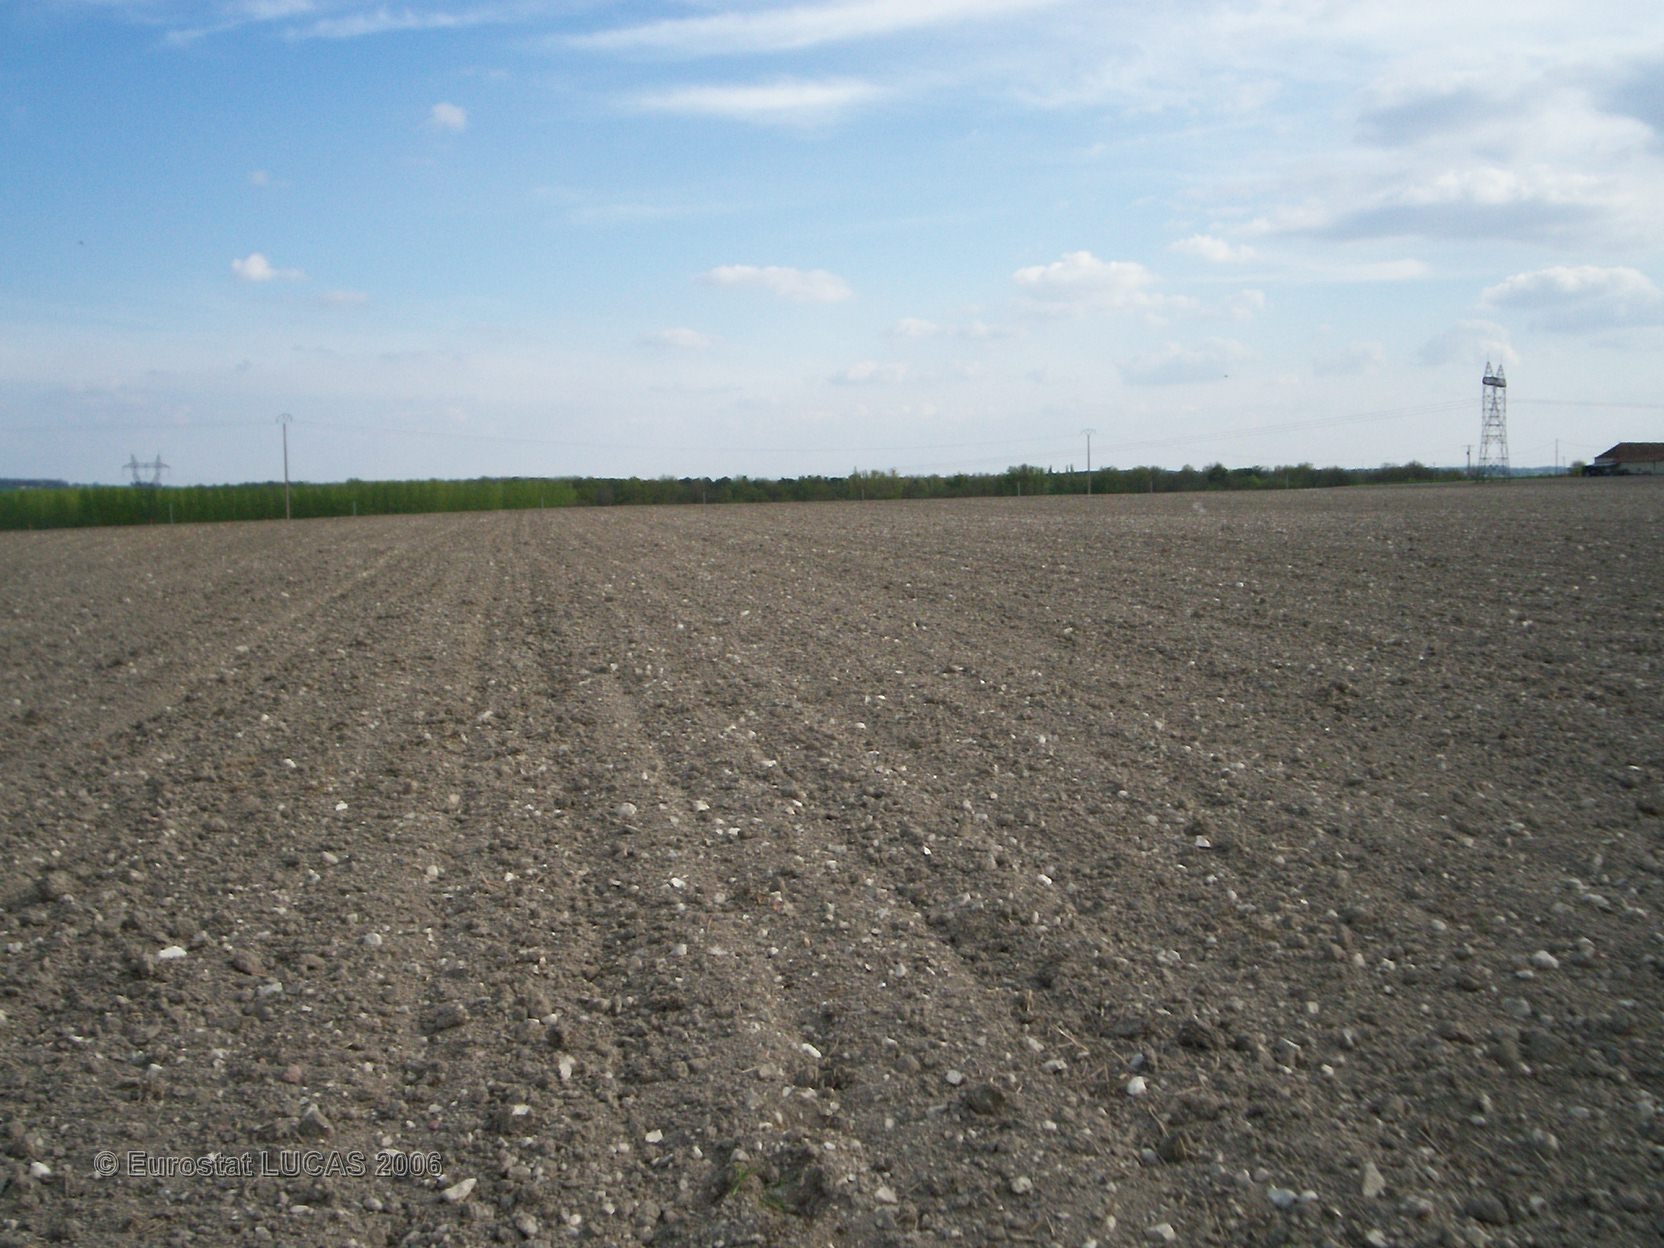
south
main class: Bare land
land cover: Bare land
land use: Agriculture (excluding fallow land and kitchen gardens)
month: April
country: FR
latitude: 46.9520
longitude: 0.4012
